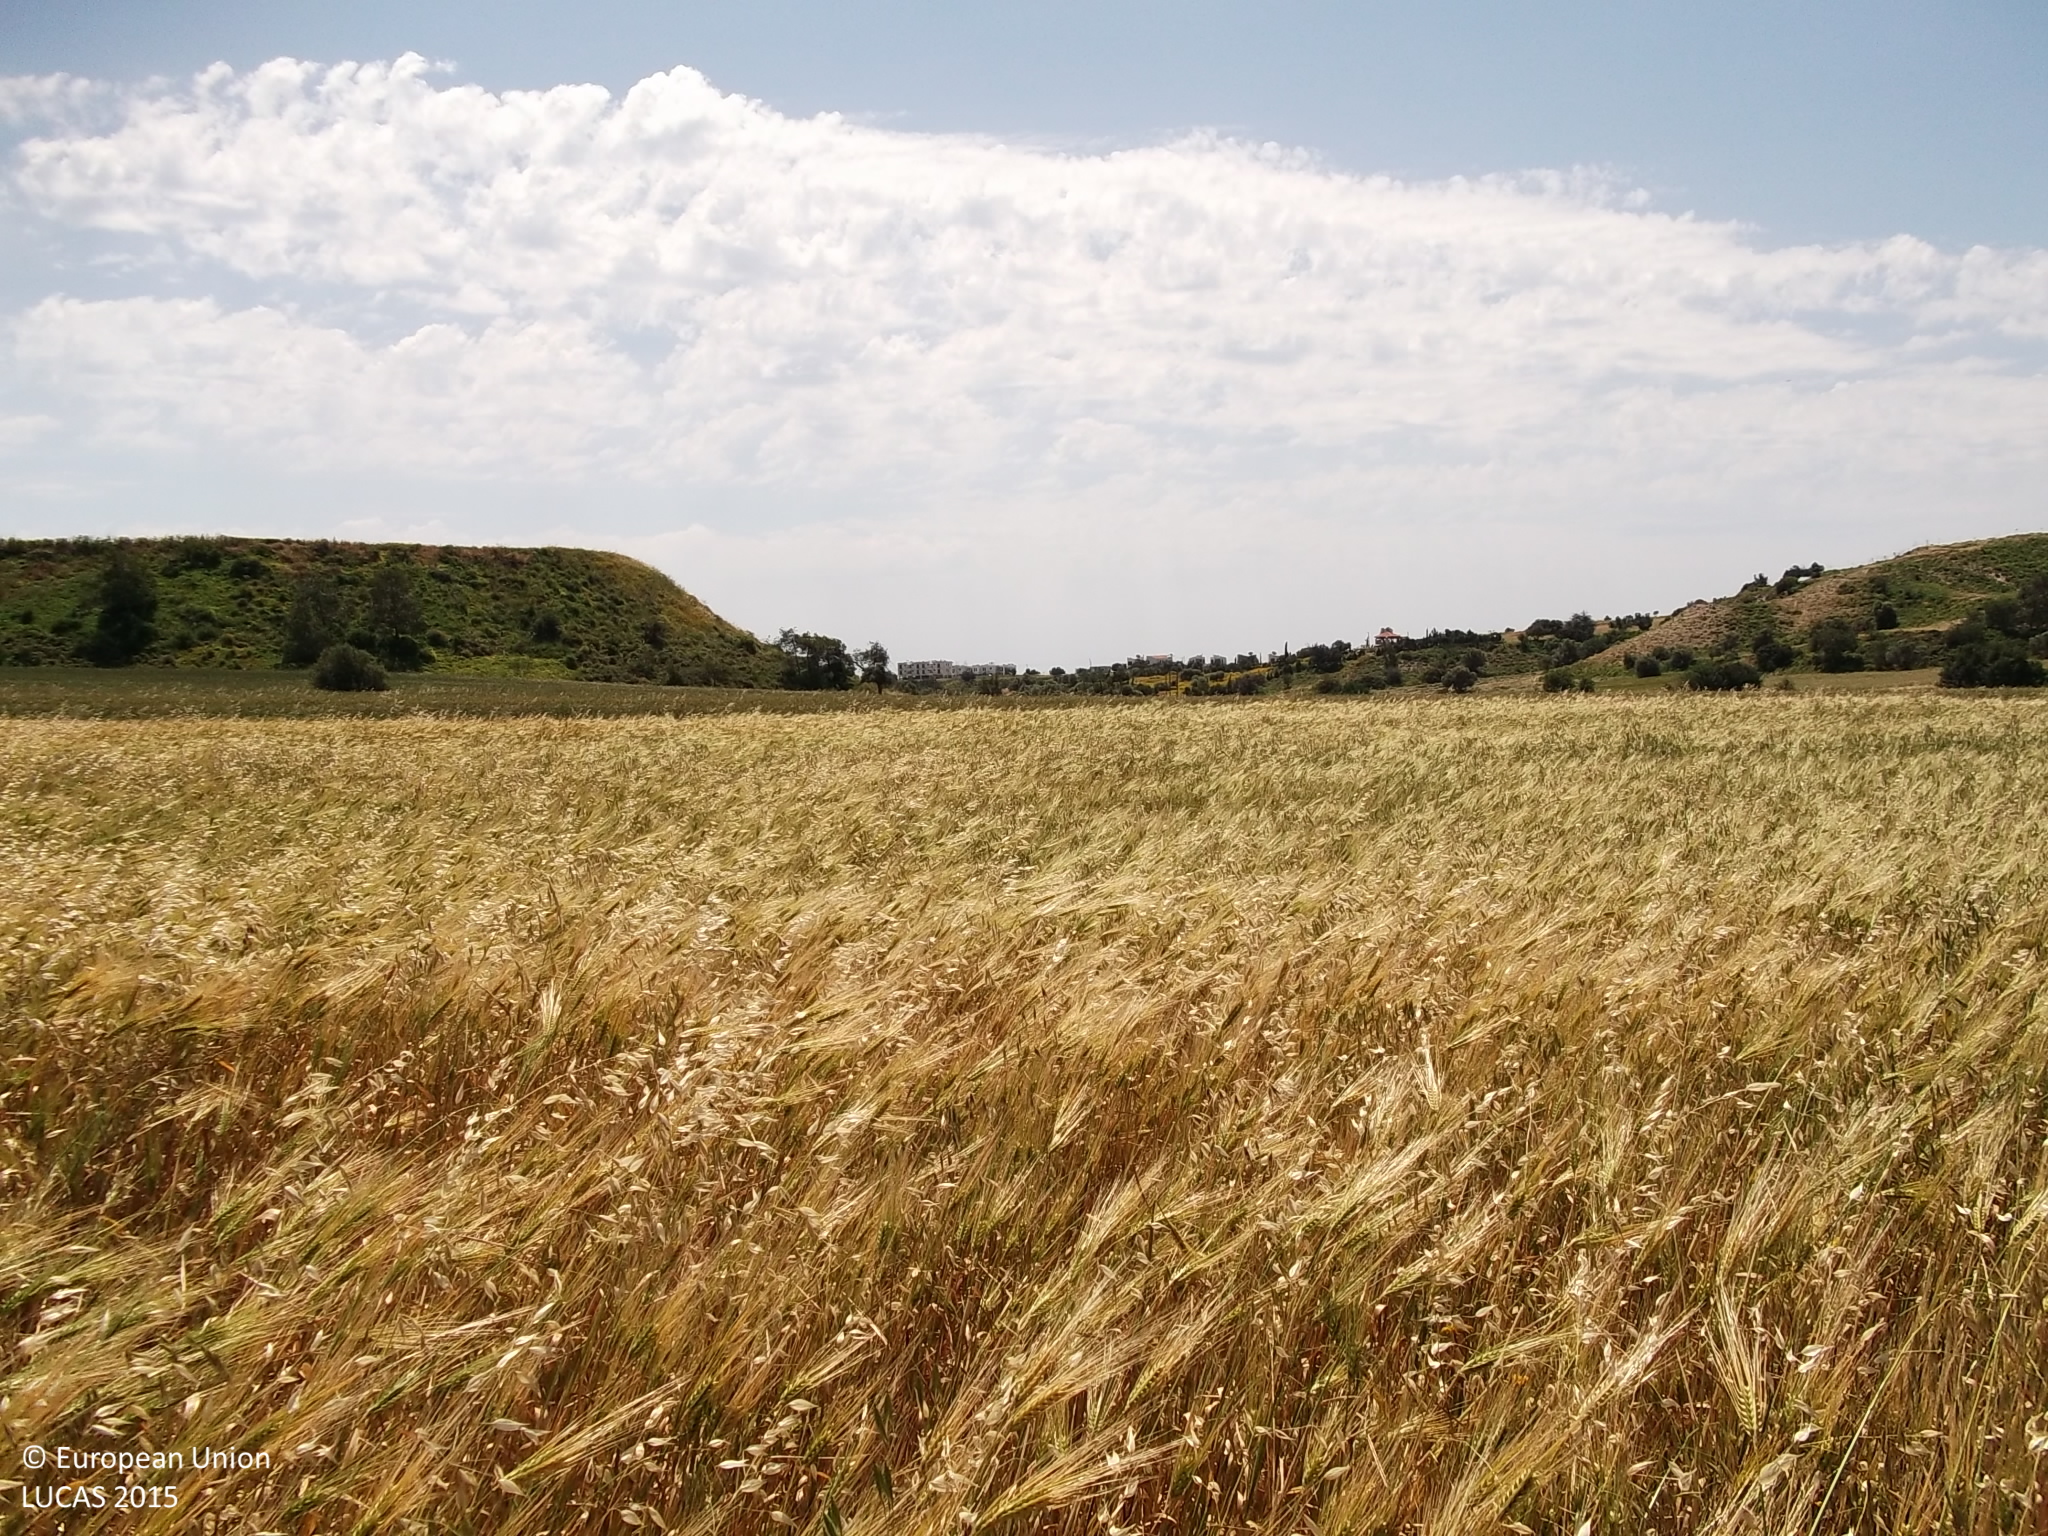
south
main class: Cropland
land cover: Mixed cereals for fodder
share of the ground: > 75 %
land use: Agriculture (excluding fallow land and kitchen gardens)
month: April
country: CY
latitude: 34.8188
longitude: 33.4847
